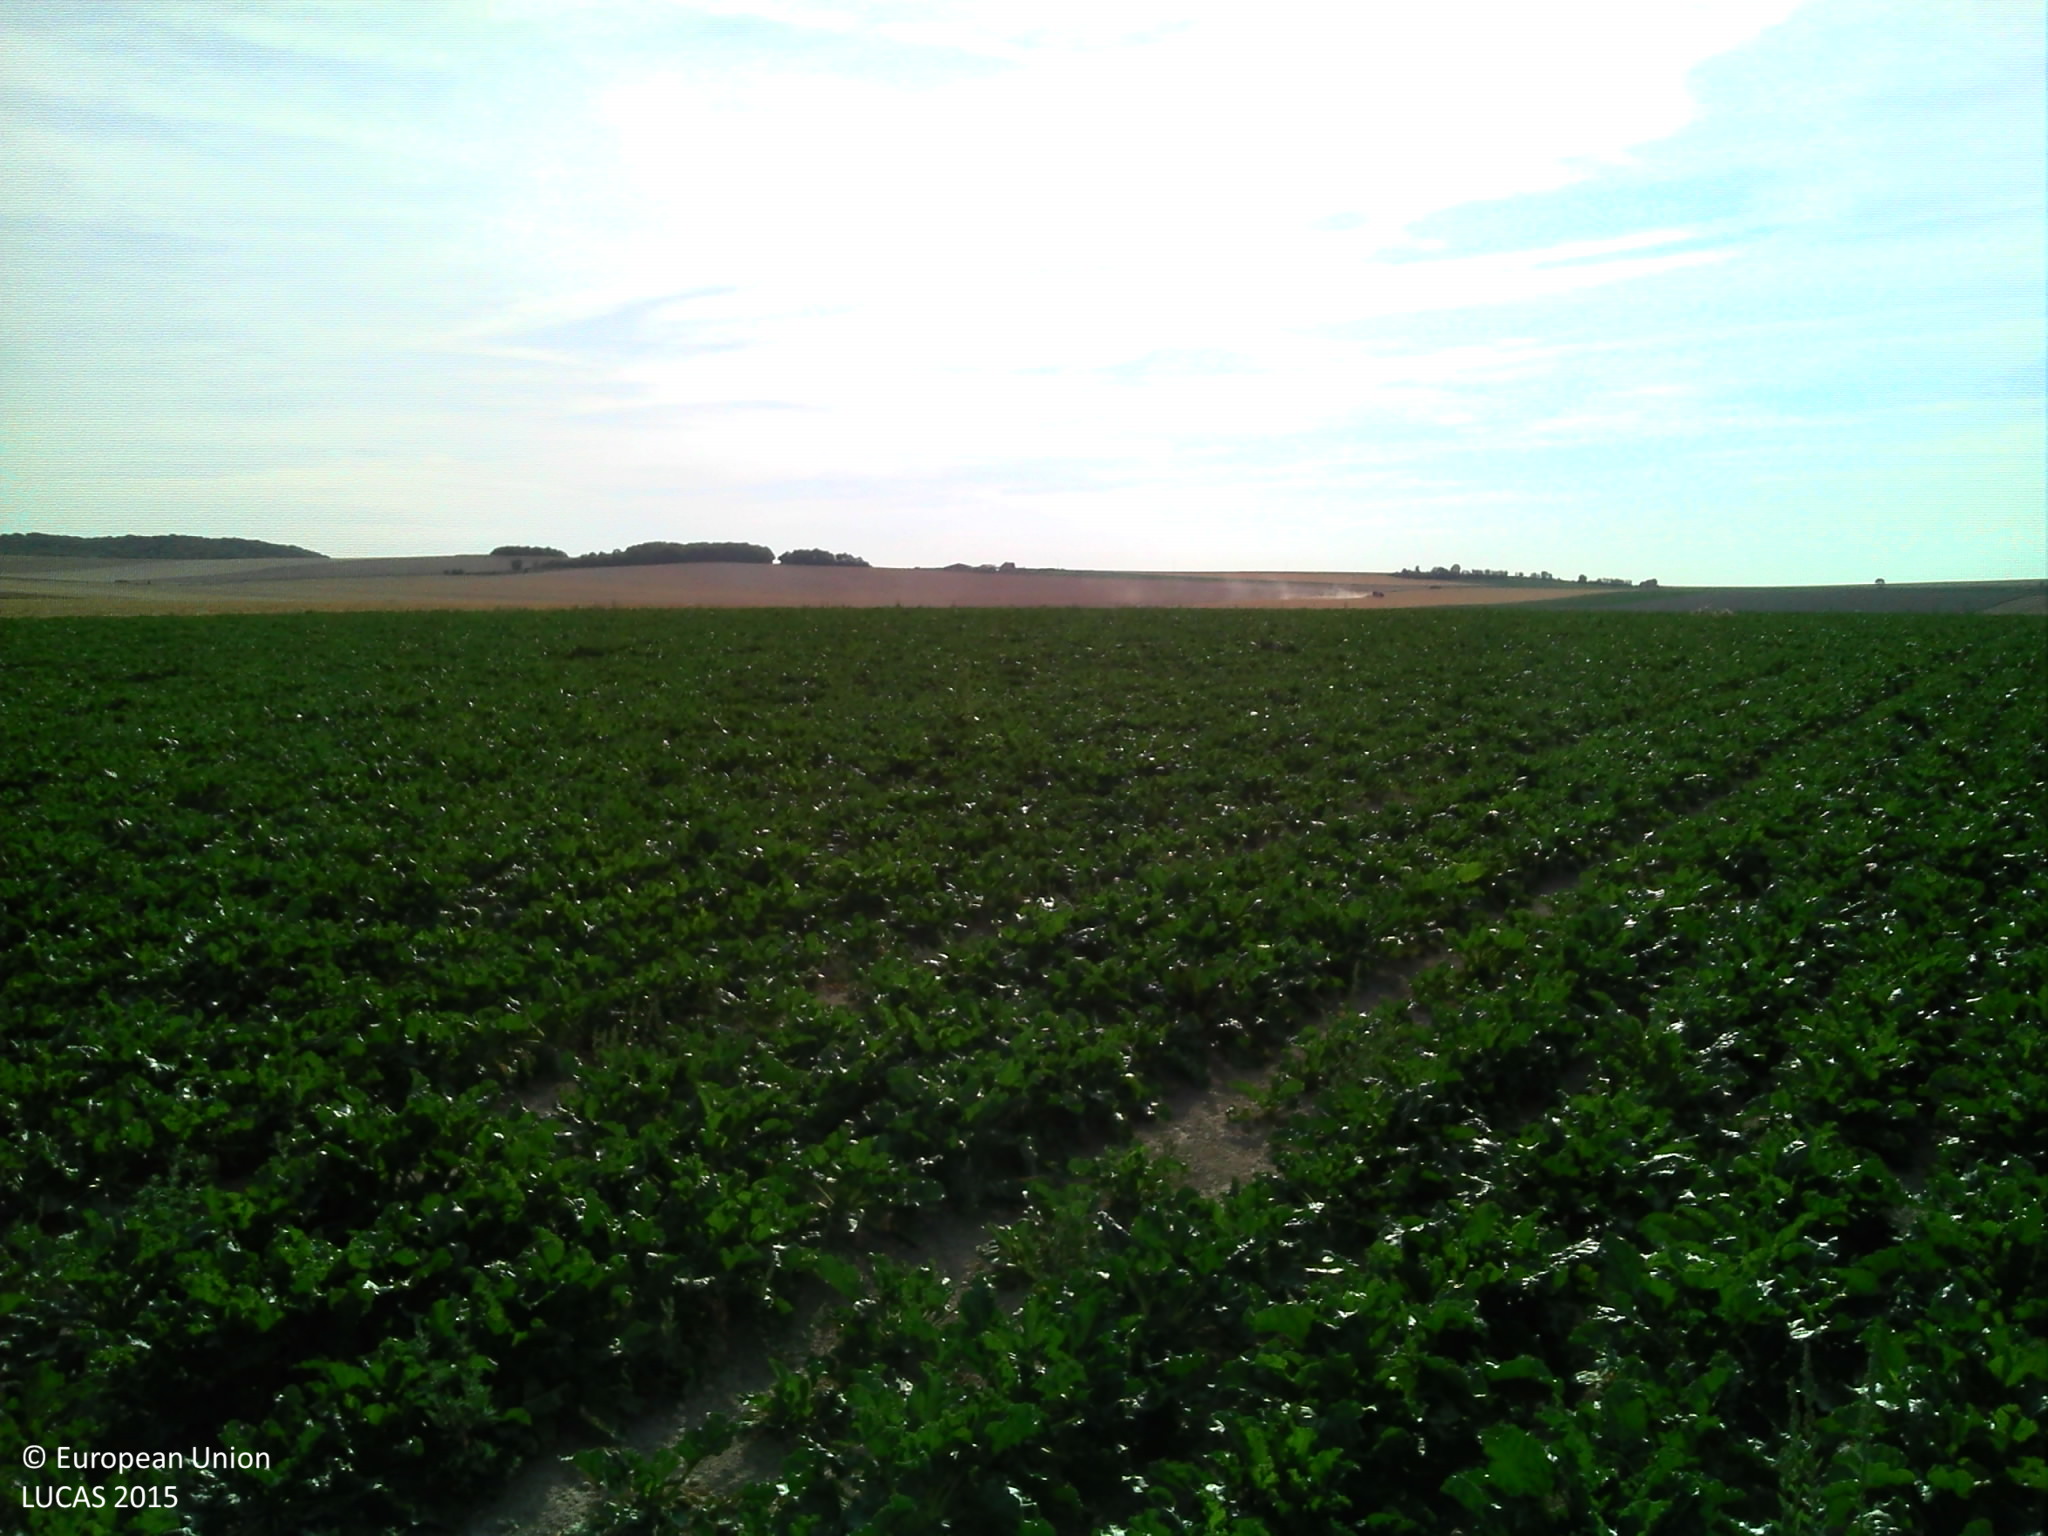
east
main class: Cropland
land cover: Sugar beet
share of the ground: > 75 %
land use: Agriculture (excluding fallow land and kitchen gardens)
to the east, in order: Sugar beet; Common wheat
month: August
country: FR
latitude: 49.2382
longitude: 4.1031
